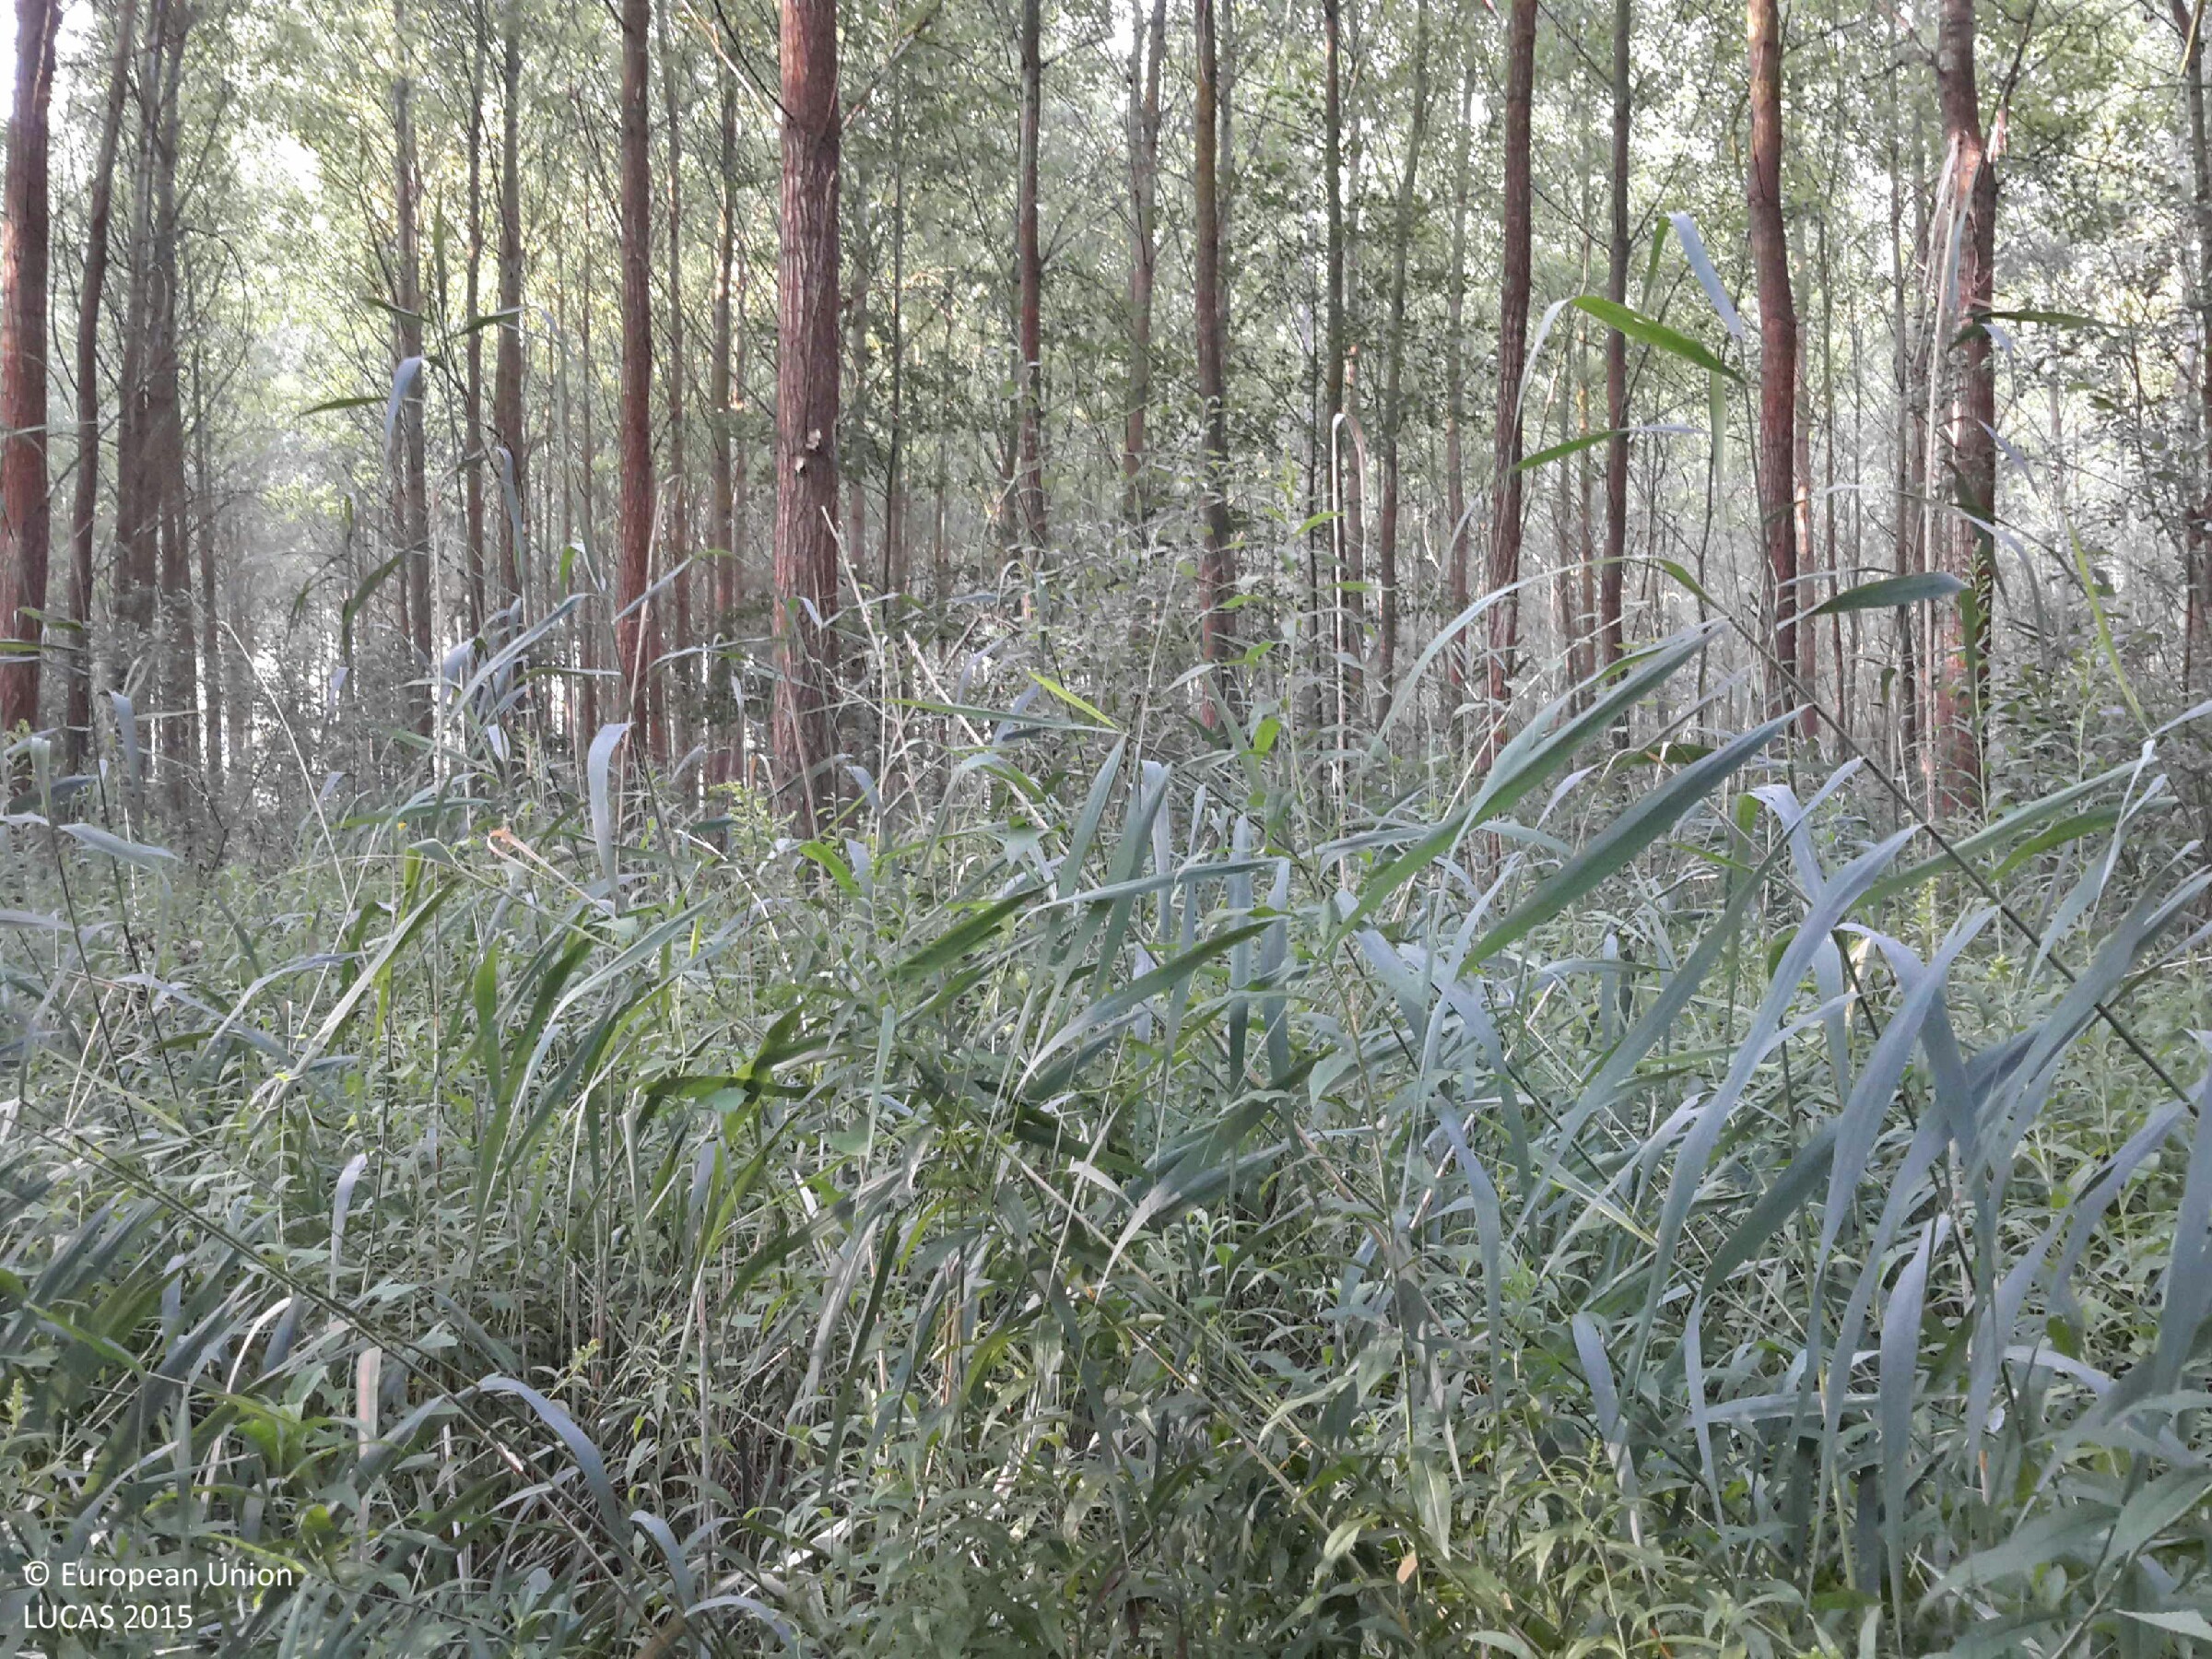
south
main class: Woodland
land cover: Broadleaved woodland
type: mesophytic deciduous forest
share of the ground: > 75 %
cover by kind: broadleaved forest trees 90 %, herbaceous plants 10 %
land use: Forestry
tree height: > 5 m
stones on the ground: < 10 %
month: August
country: HU
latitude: 47.7301
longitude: 17.2743
